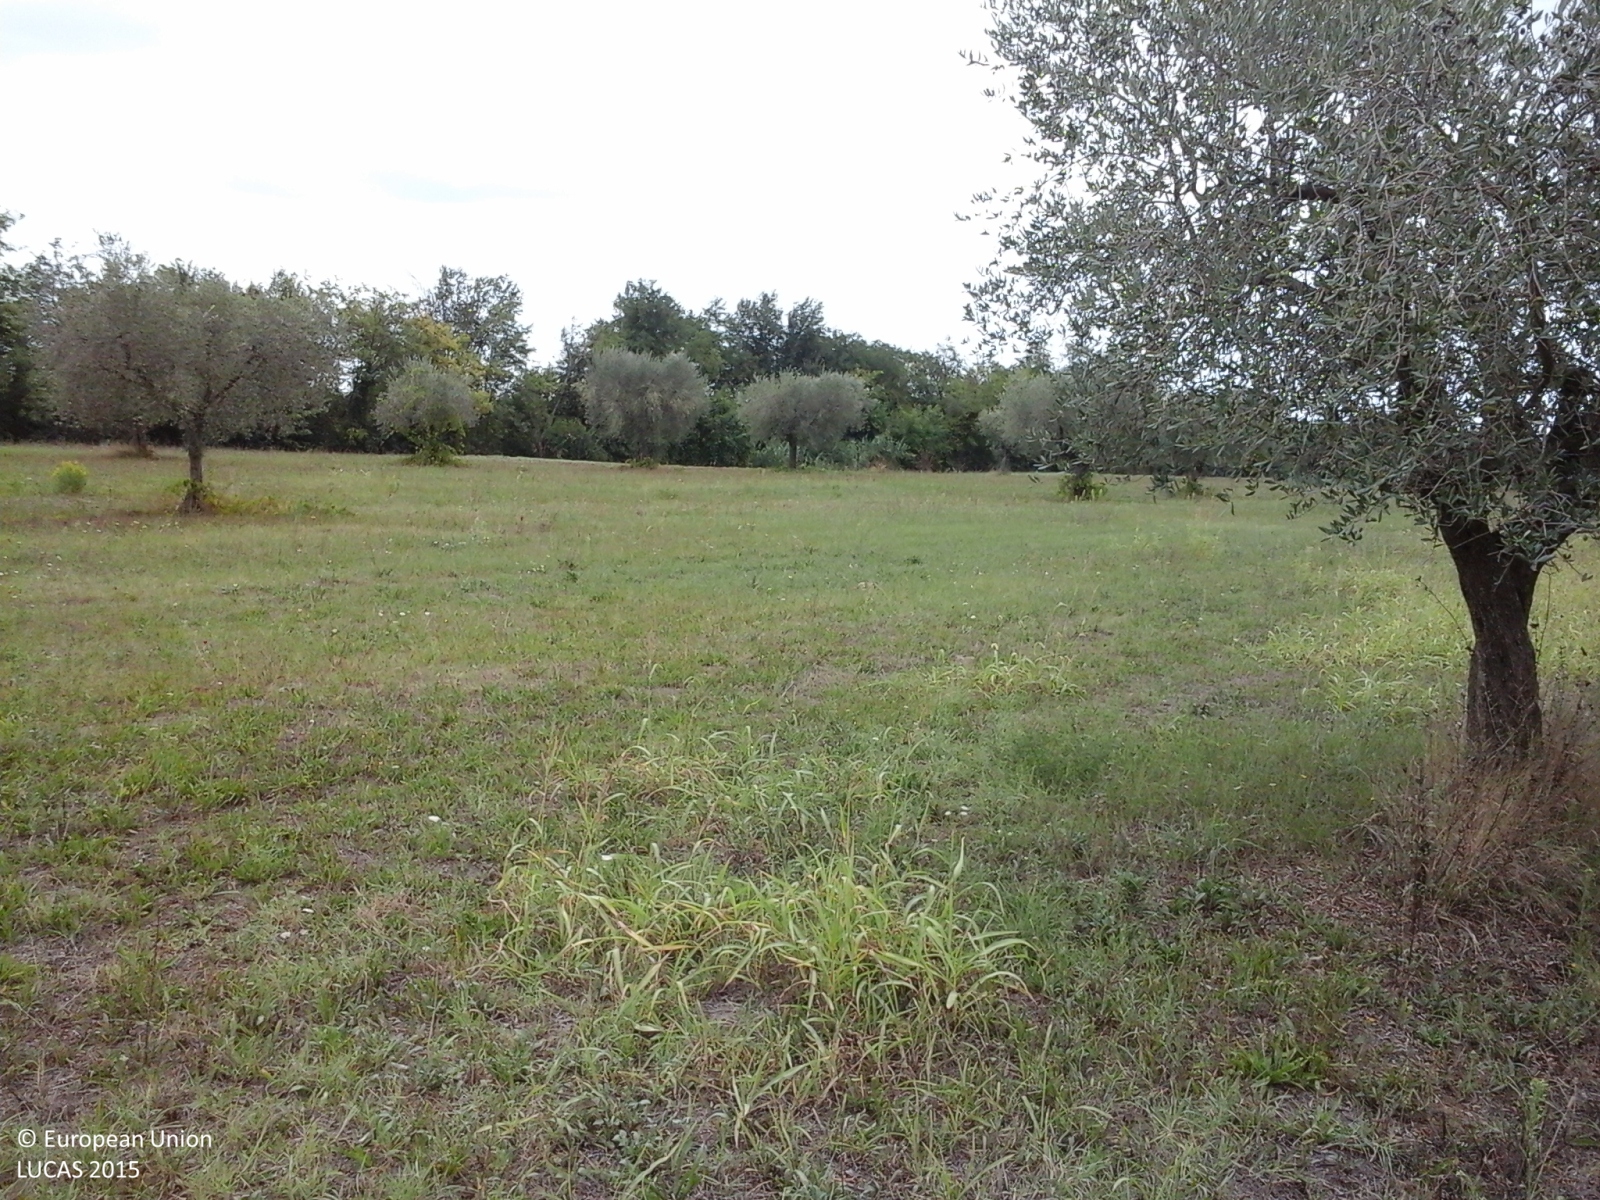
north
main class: Cropland
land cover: Olive groves
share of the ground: < 10 %
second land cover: Spontaneously vegetated surfaces
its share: > 75 %
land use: Agriculture (excluding fallow land and kitchen gardens)
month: September
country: IT
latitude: 42.7991
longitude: 13.8163
